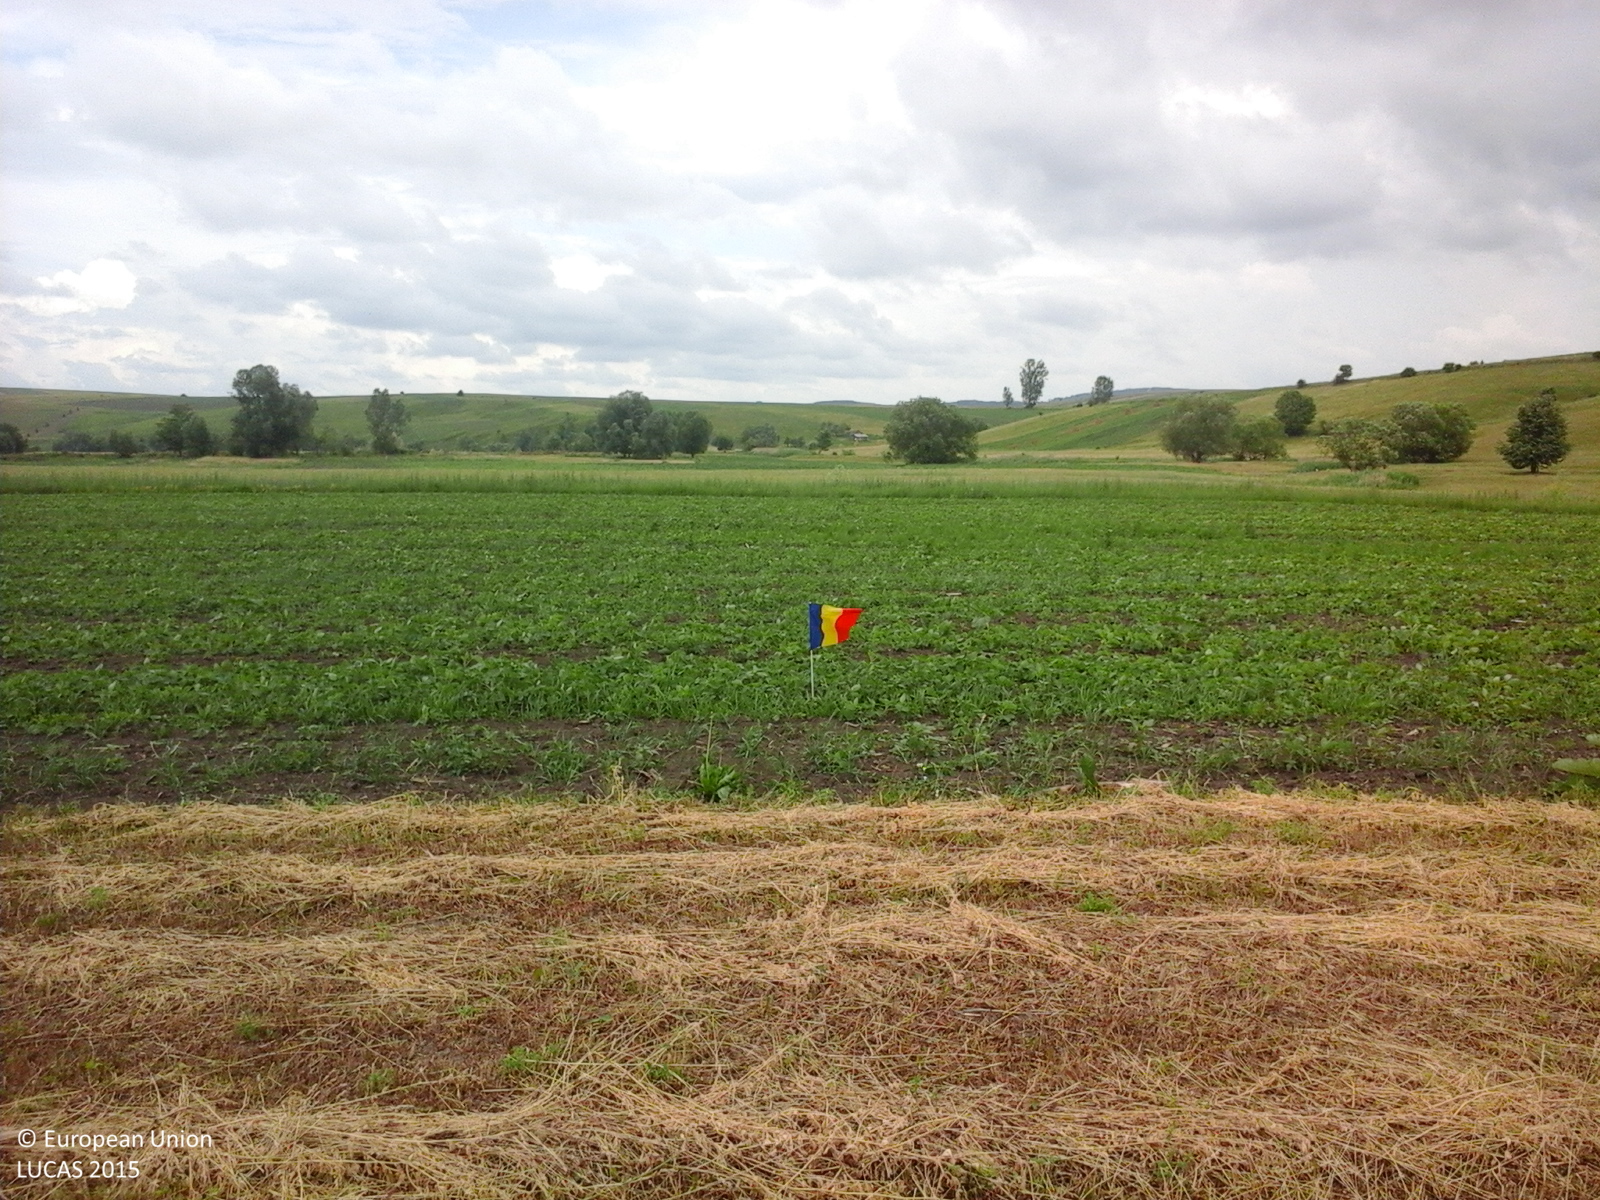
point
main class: Cropland
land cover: Soya
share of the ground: > 75 %
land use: Agriculture (excluding fallow land and kitchen gardens)
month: May
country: RO
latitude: 47.1402
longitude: 26.3400
